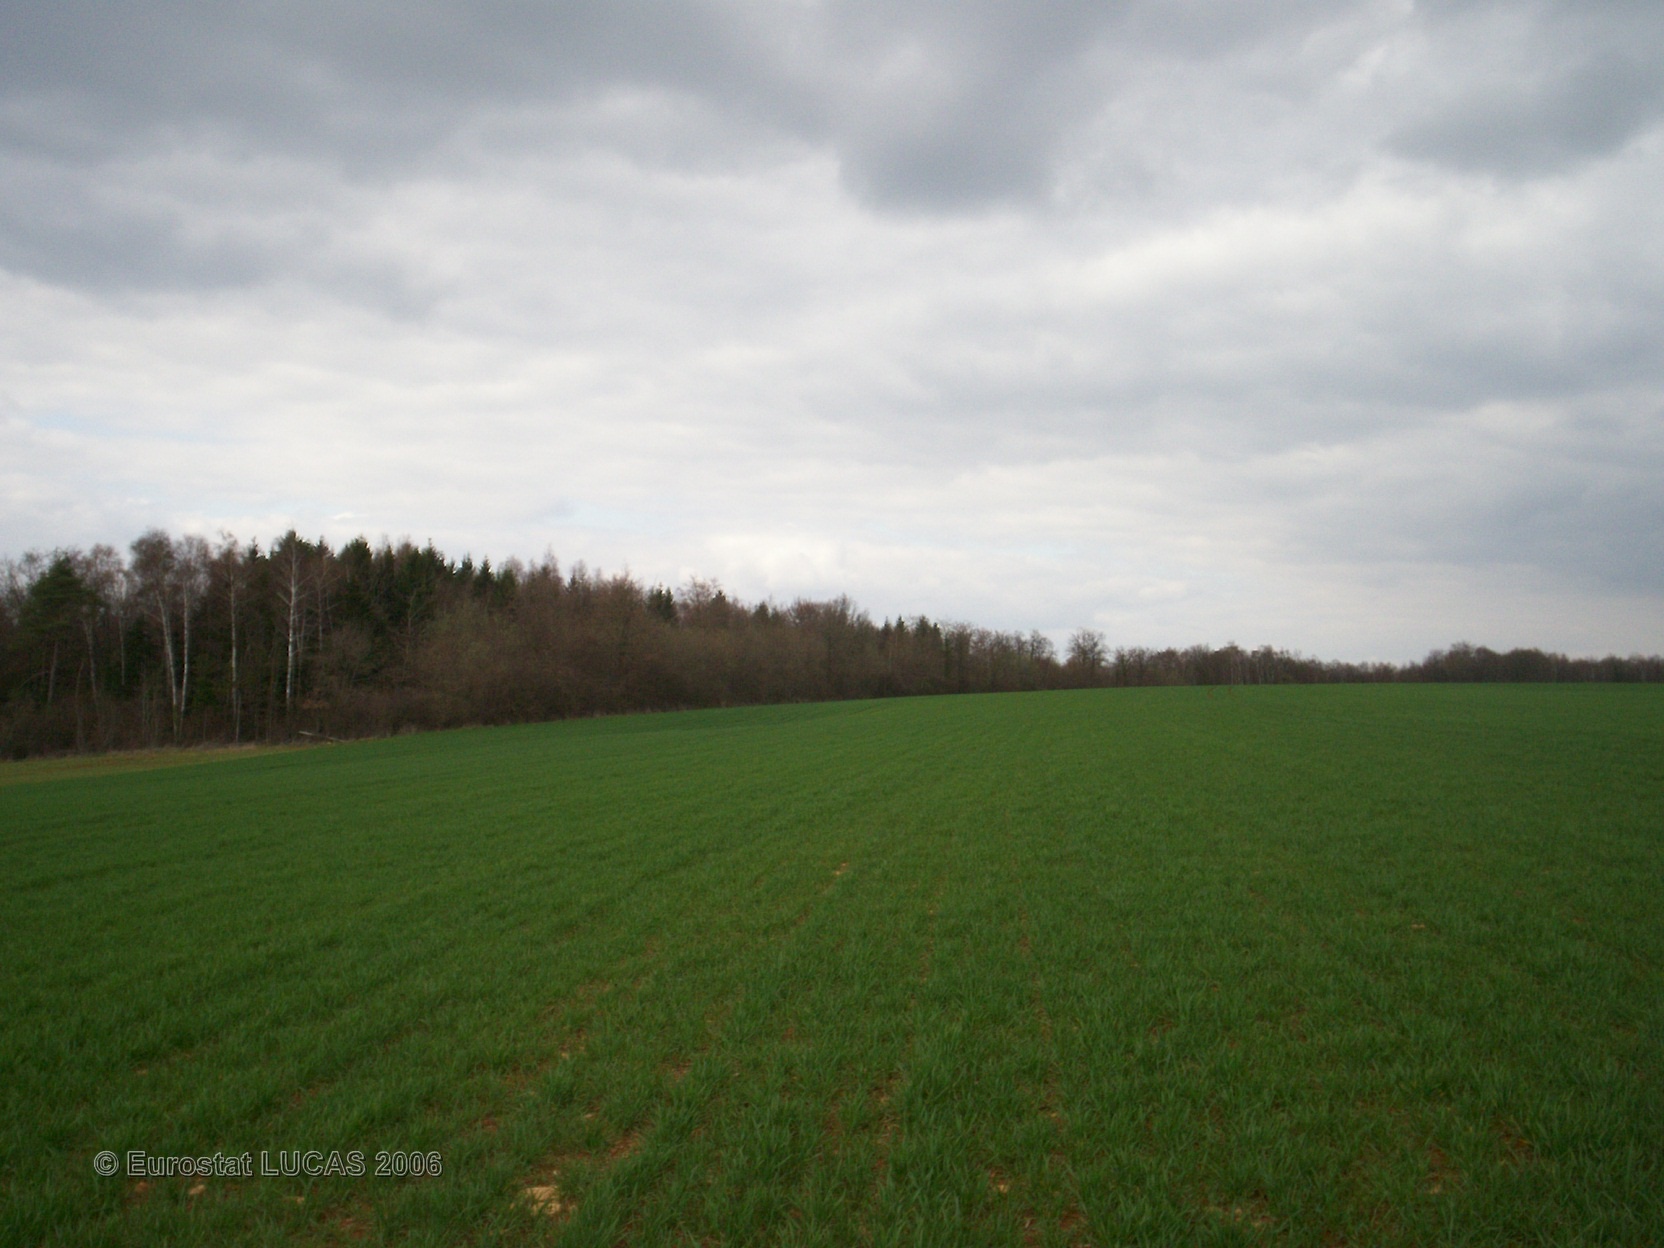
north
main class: Cropland
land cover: Common wheat
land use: Agriculture (excluding fallow land and kitchen gardens)
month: April
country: FR
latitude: 49.5716
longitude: 5.0332
